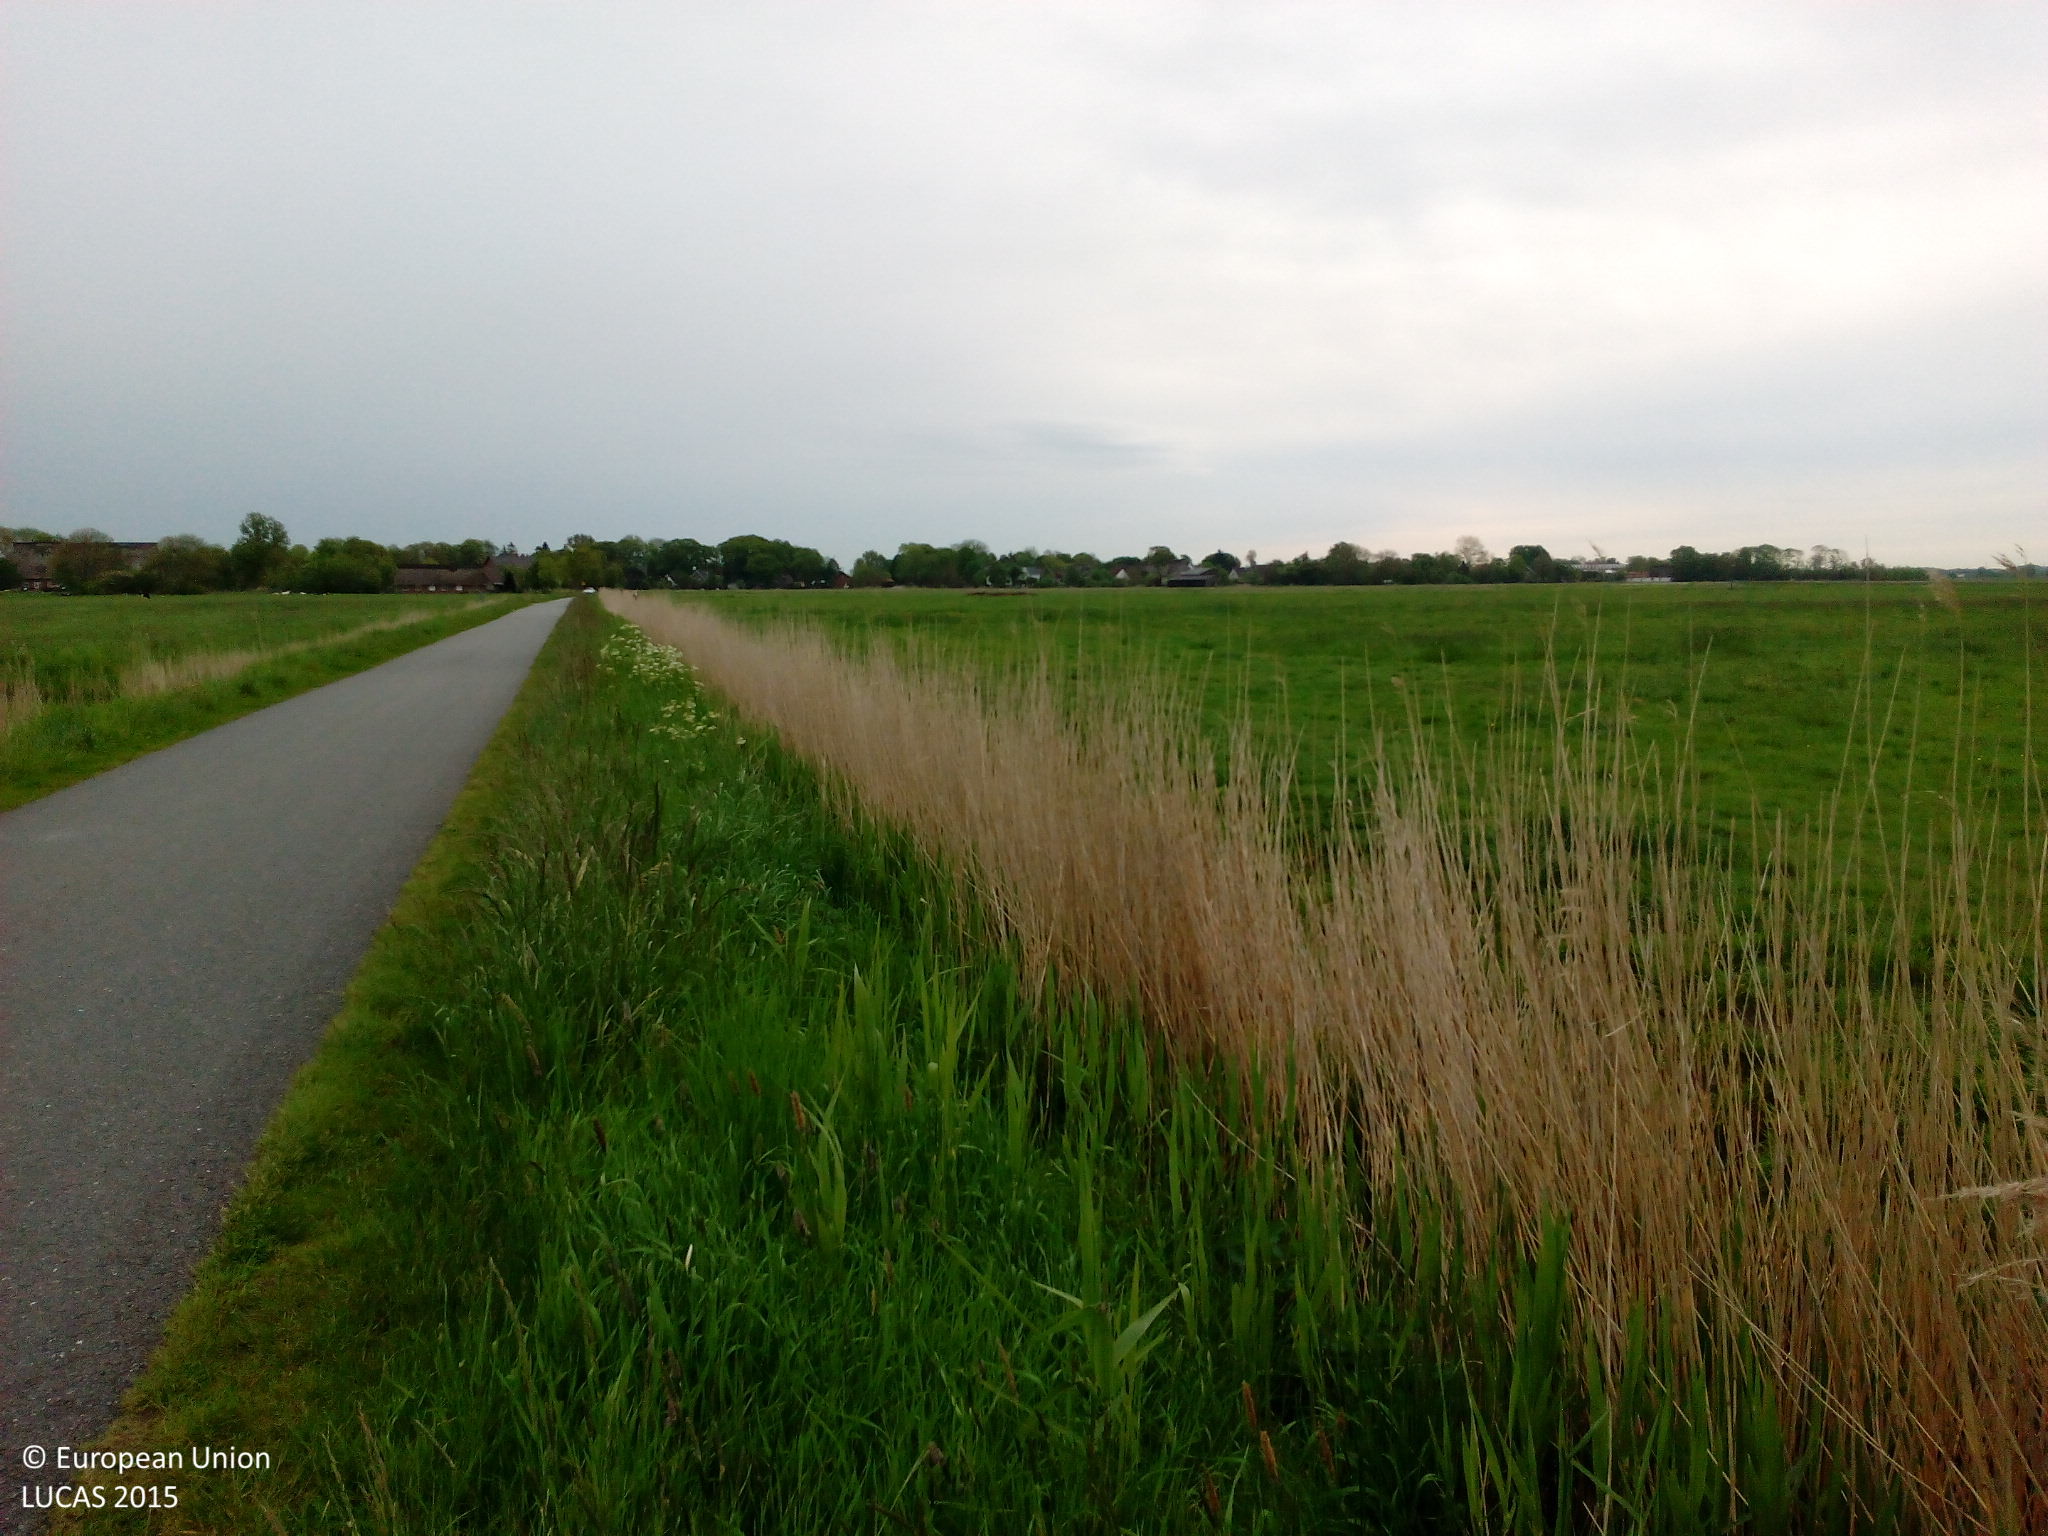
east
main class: Grassland
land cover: Grassland without tree/shrub cover
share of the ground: > 75 %
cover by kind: herbaceous plants 100 %
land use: Agriculture (excluding fallow land and kitchen gardens)
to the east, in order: Grassland without tree/shrub cover; Fences; Grassland without tree/shrub cover; Ditches and canals; Grassland without tree/shrub cover; Ditches and canals; Grassland without tree/shrub cover
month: May
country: DE
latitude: 53.4467
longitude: 8.5100
